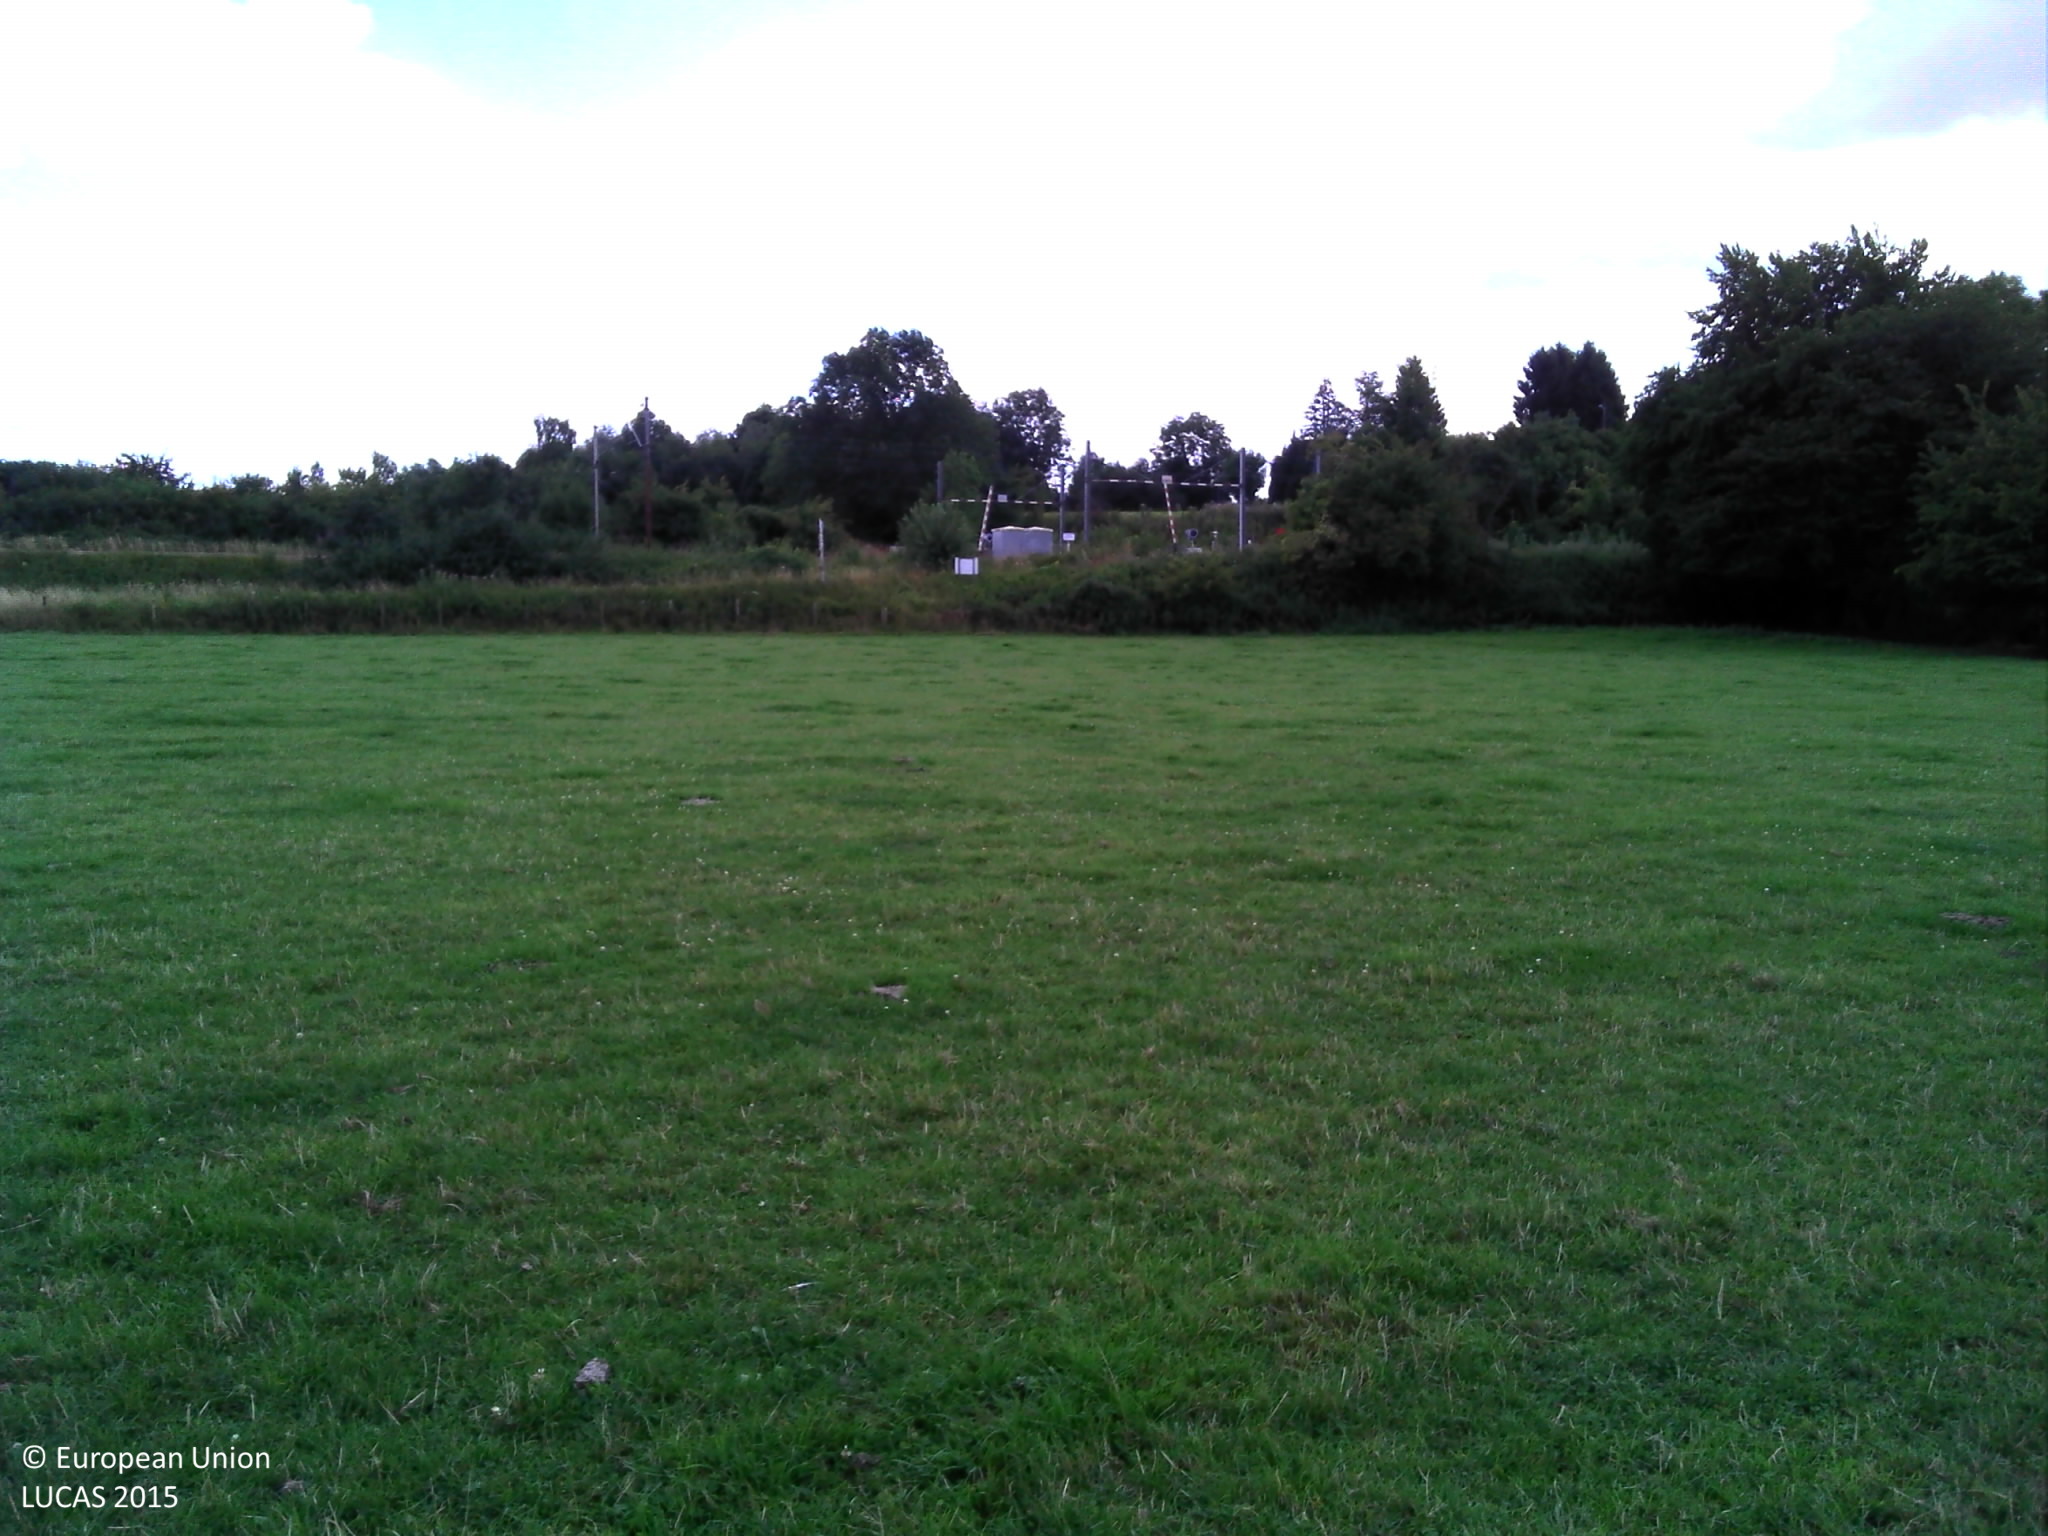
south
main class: Grassland
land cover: Grassland without tree/shrub cover
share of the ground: > 75 %
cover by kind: herbaceous plants 100 %
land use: Agriculture (excluding fallow land and kitchen gardens)
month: August
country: FR
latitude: 50.2788
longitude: 4.0023
